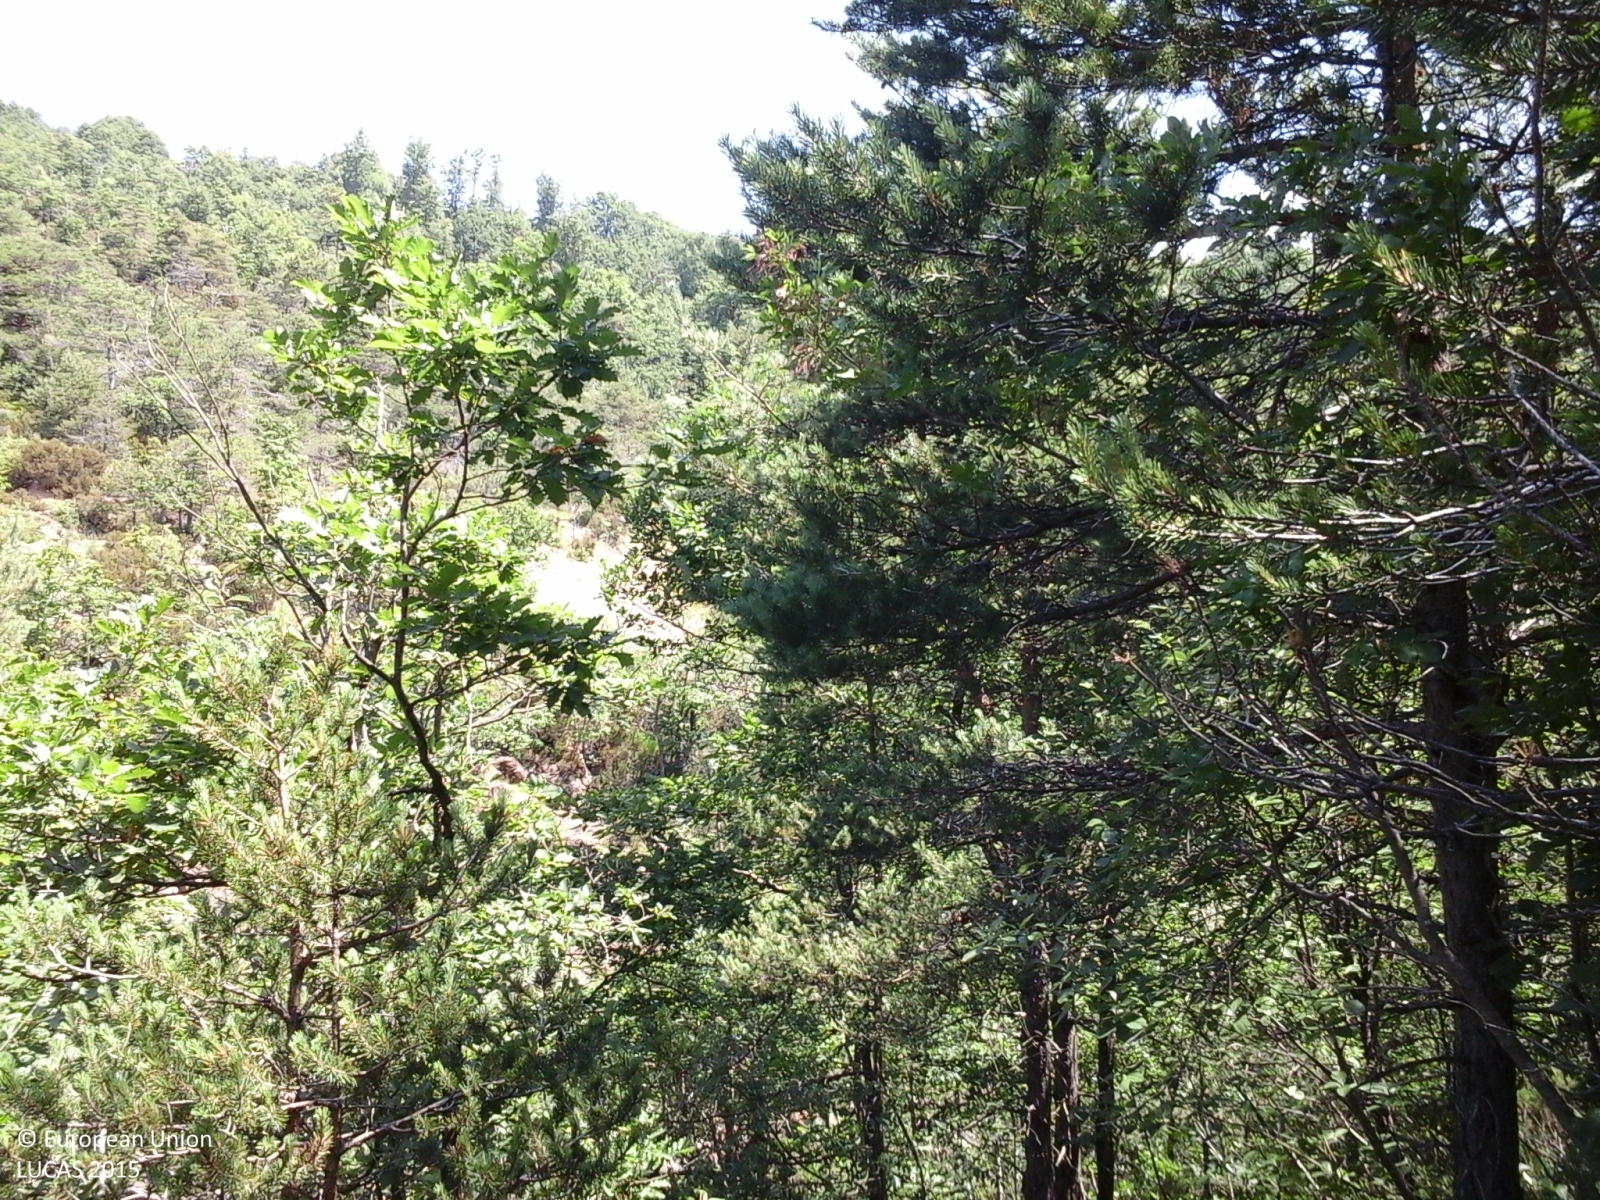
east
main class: Woodland
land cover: Pine dominated mixed woodland
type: coniferous forest of the mediterranean region
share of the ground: > 75 %
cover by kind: coniferous forest trees 45 %, broadleaved forest trees 25 %, shrubs 15 %, herbaceous plants 10 %, consolidated bare surface 5 %
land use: Forestry
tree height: > 5 m
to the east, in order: Pine dominated mixed woodland; Inland fresh running water; Grassland with sparse tree/shrub cover; Pine dominated mixed woodland; Tracks; Pine dominated mixed woodland; Shrubland with sparse tree cover; Pine dominated mixed woodland; Rocks and stones; Pine dominated mixed woodland; Ditches and canals; Pine dominated mixed woodland
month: June
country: IT
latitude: 44.5202
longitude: 8.5060
